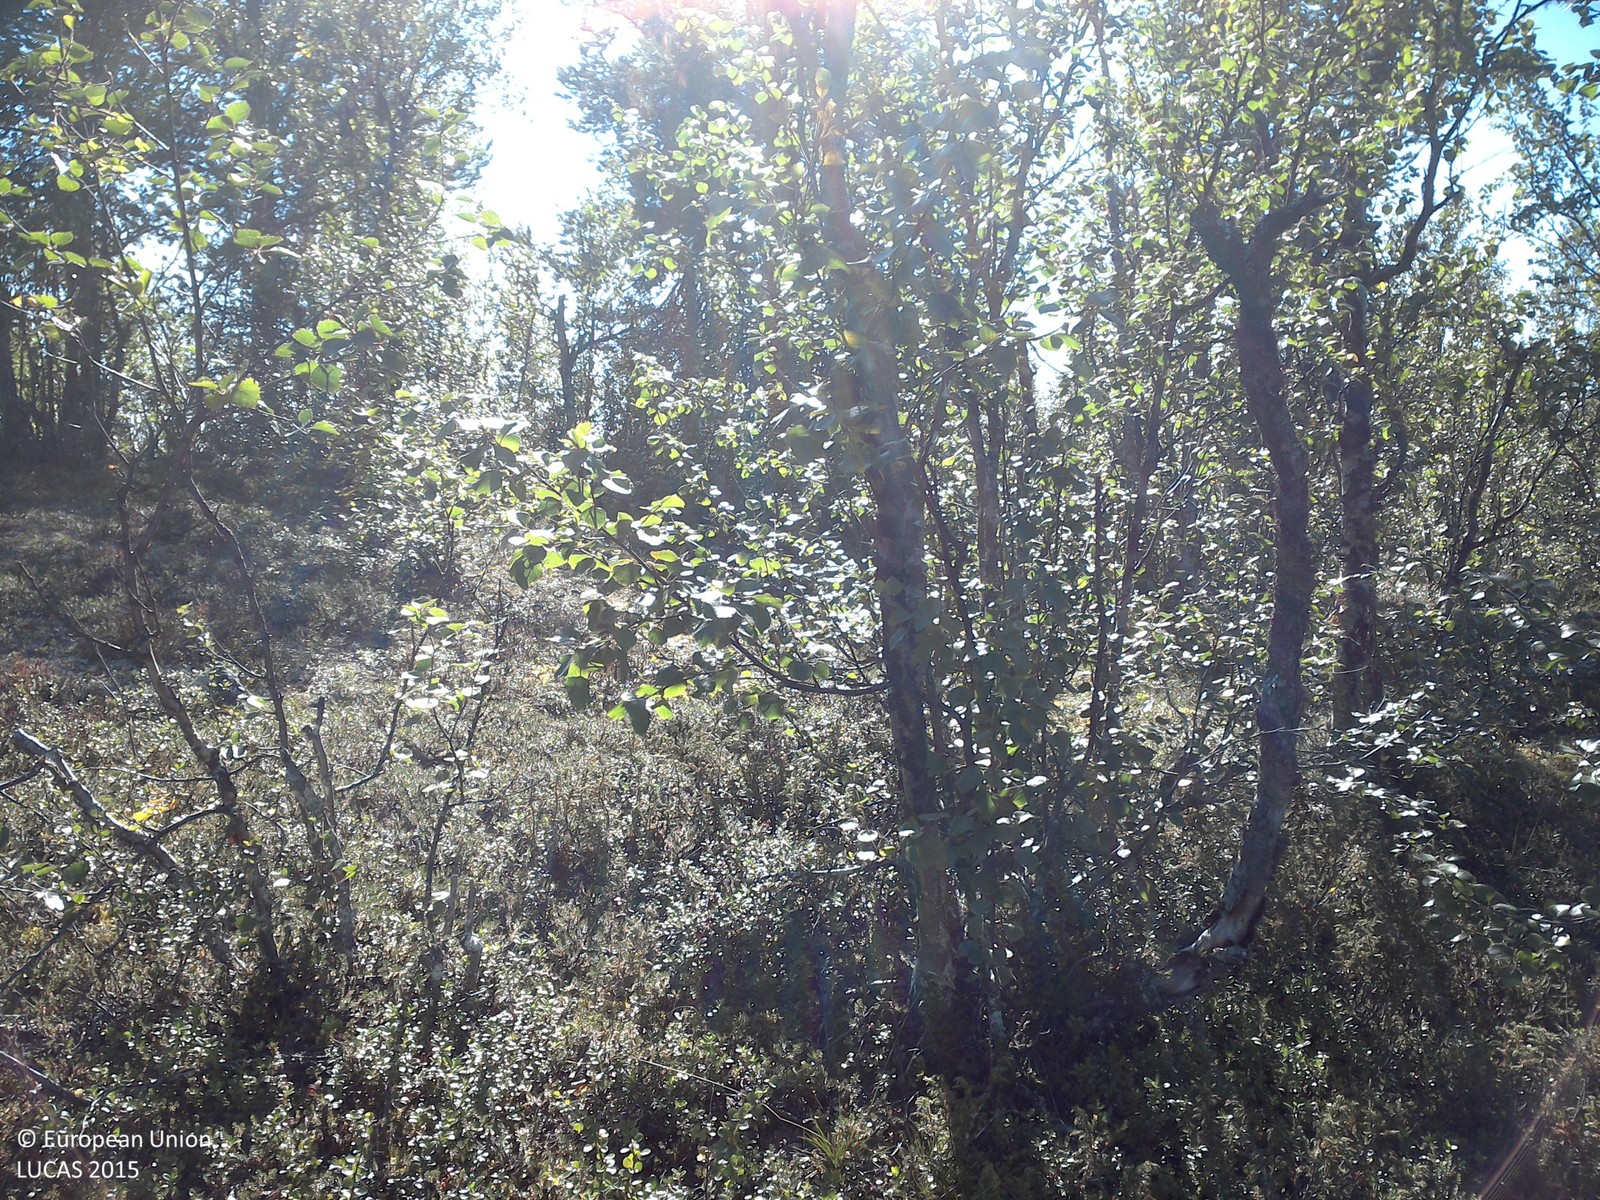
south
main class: Woodland
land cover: Broadleaved woodland
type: boreal forest
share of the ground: 10 - 25 %
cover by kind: shrubs 65 %, broadleaved forest trees 15 %, lichens and mosses 15 %, coniferous forest trees 5 %
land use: Amenities, museums, leisure
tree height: < 5 m
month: August
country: SE
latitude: 67.5457
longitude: 20.1013
